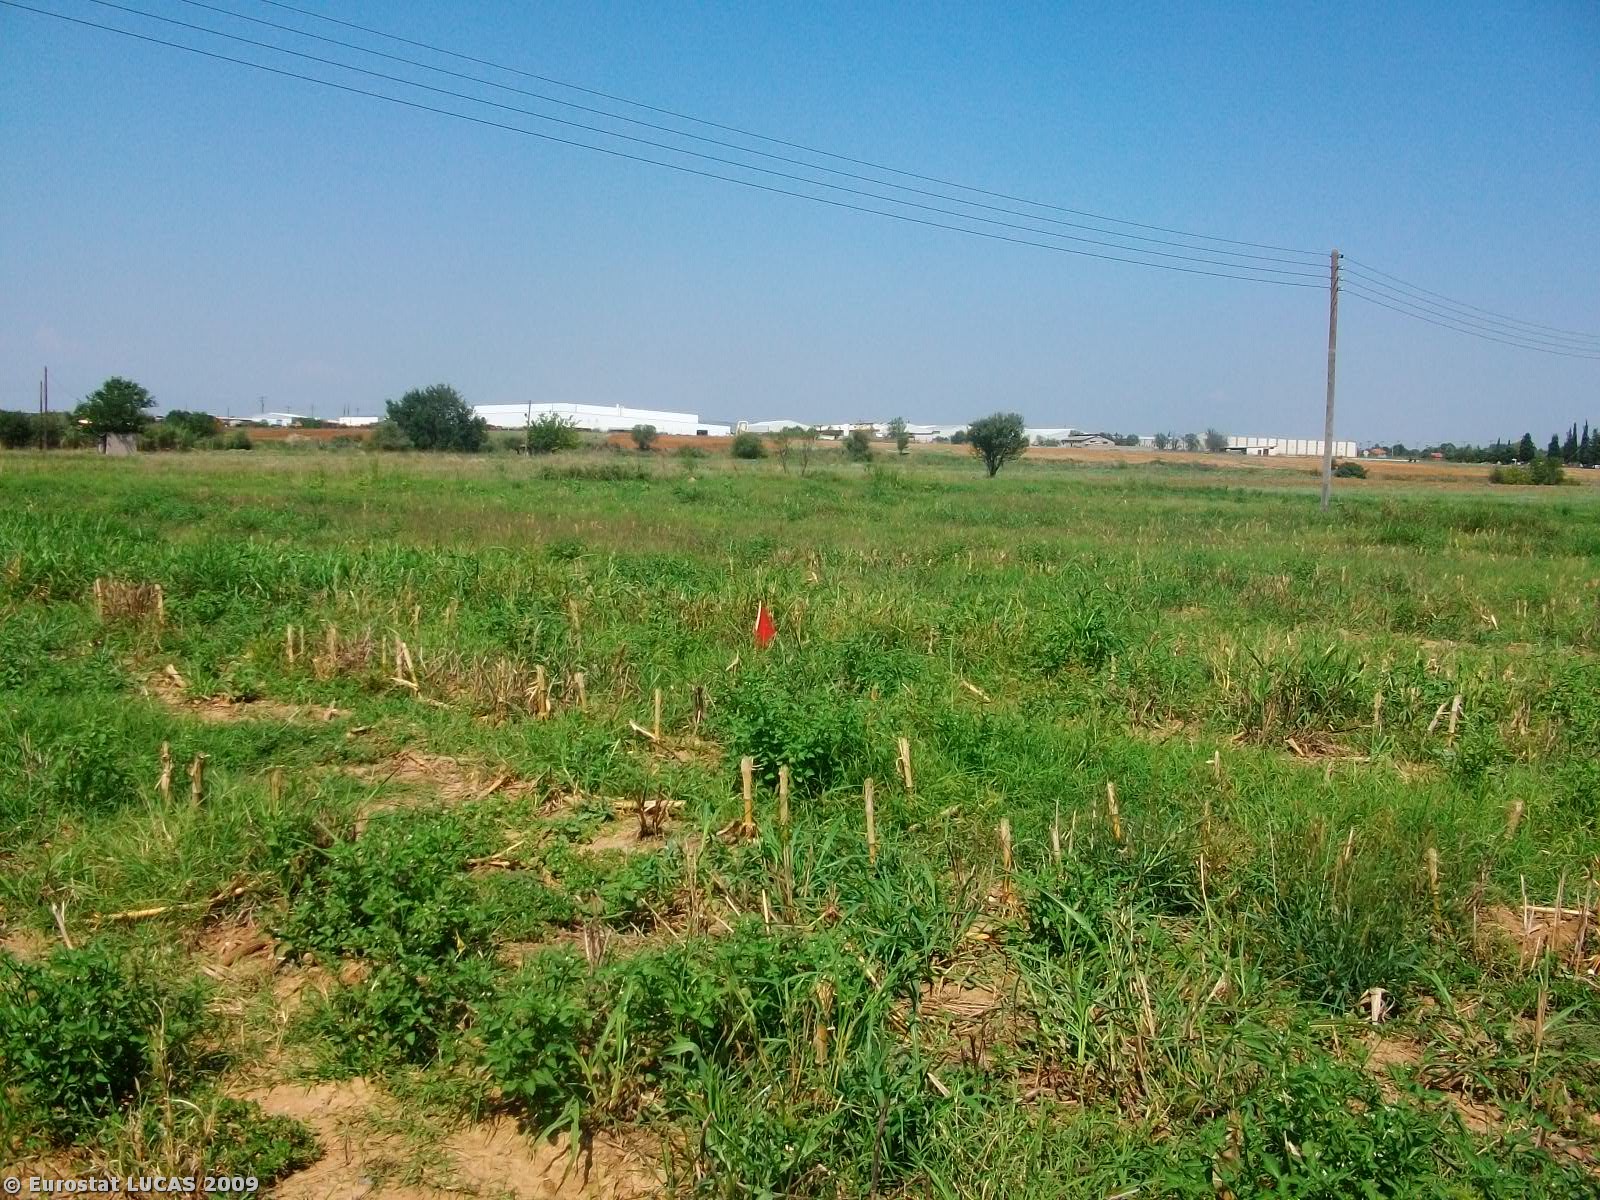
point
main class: Cropland
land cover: Maize
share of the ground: < 10 %
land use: Agriculture (excluding fallow land and kitchen gardens)
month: August
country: GR
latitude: 40.8207
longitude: 22.8967
